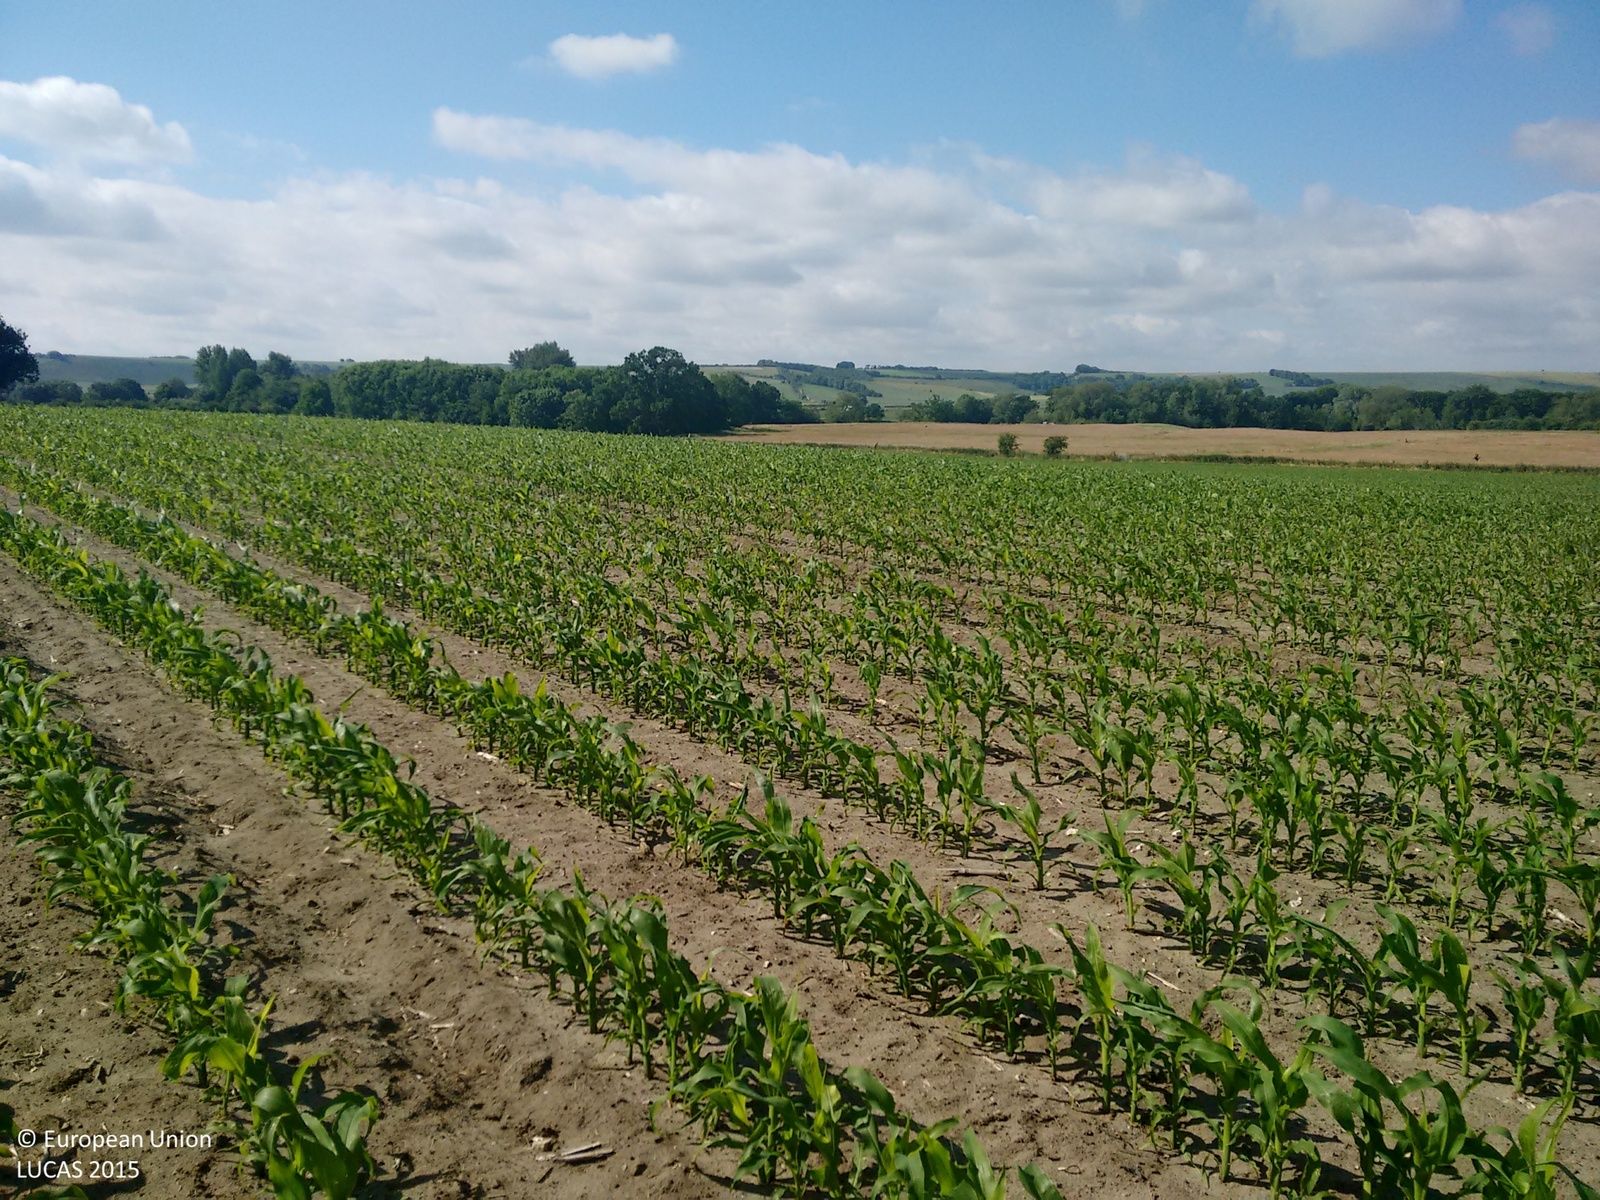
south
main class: Cropland
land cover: Maize
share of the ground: 25 - 50 %
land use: Agriculture (excluding fallow land and kitchen gardens)
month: June
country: GB
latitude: 51.3252
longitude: -1.8669
